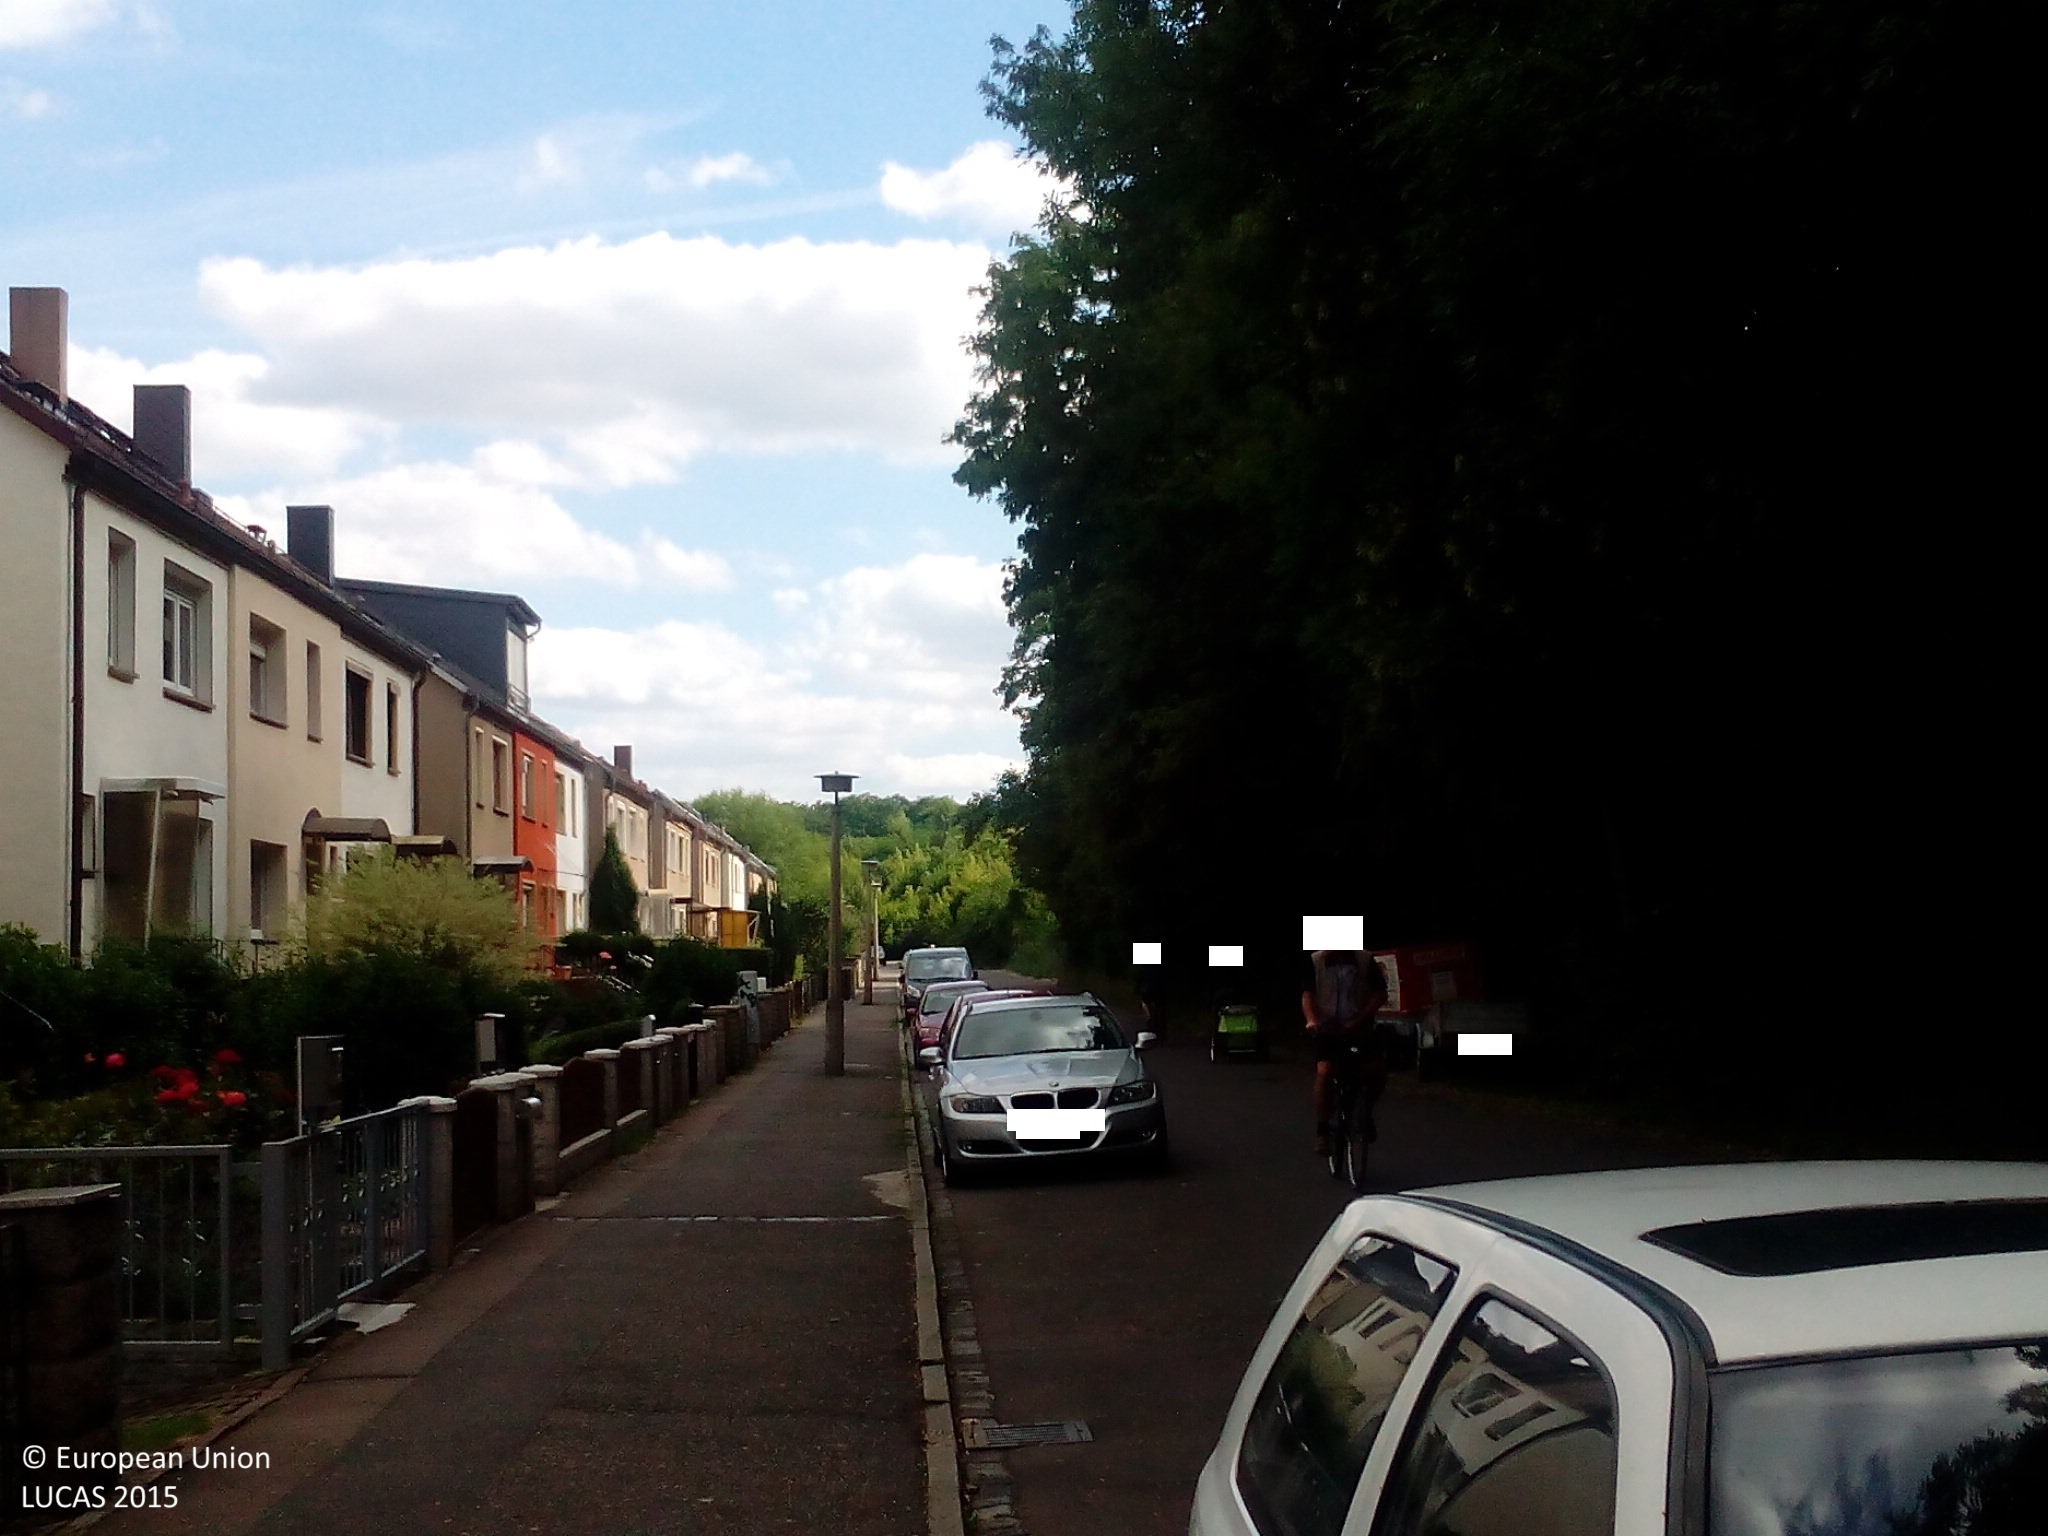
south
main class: Woodland
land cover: Broadleaved woodland
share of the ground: > 75 %
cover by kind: broadleaved forest trees 100 %
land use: Residential
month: July
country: DE
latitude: 51.3109
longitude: 12.3668
